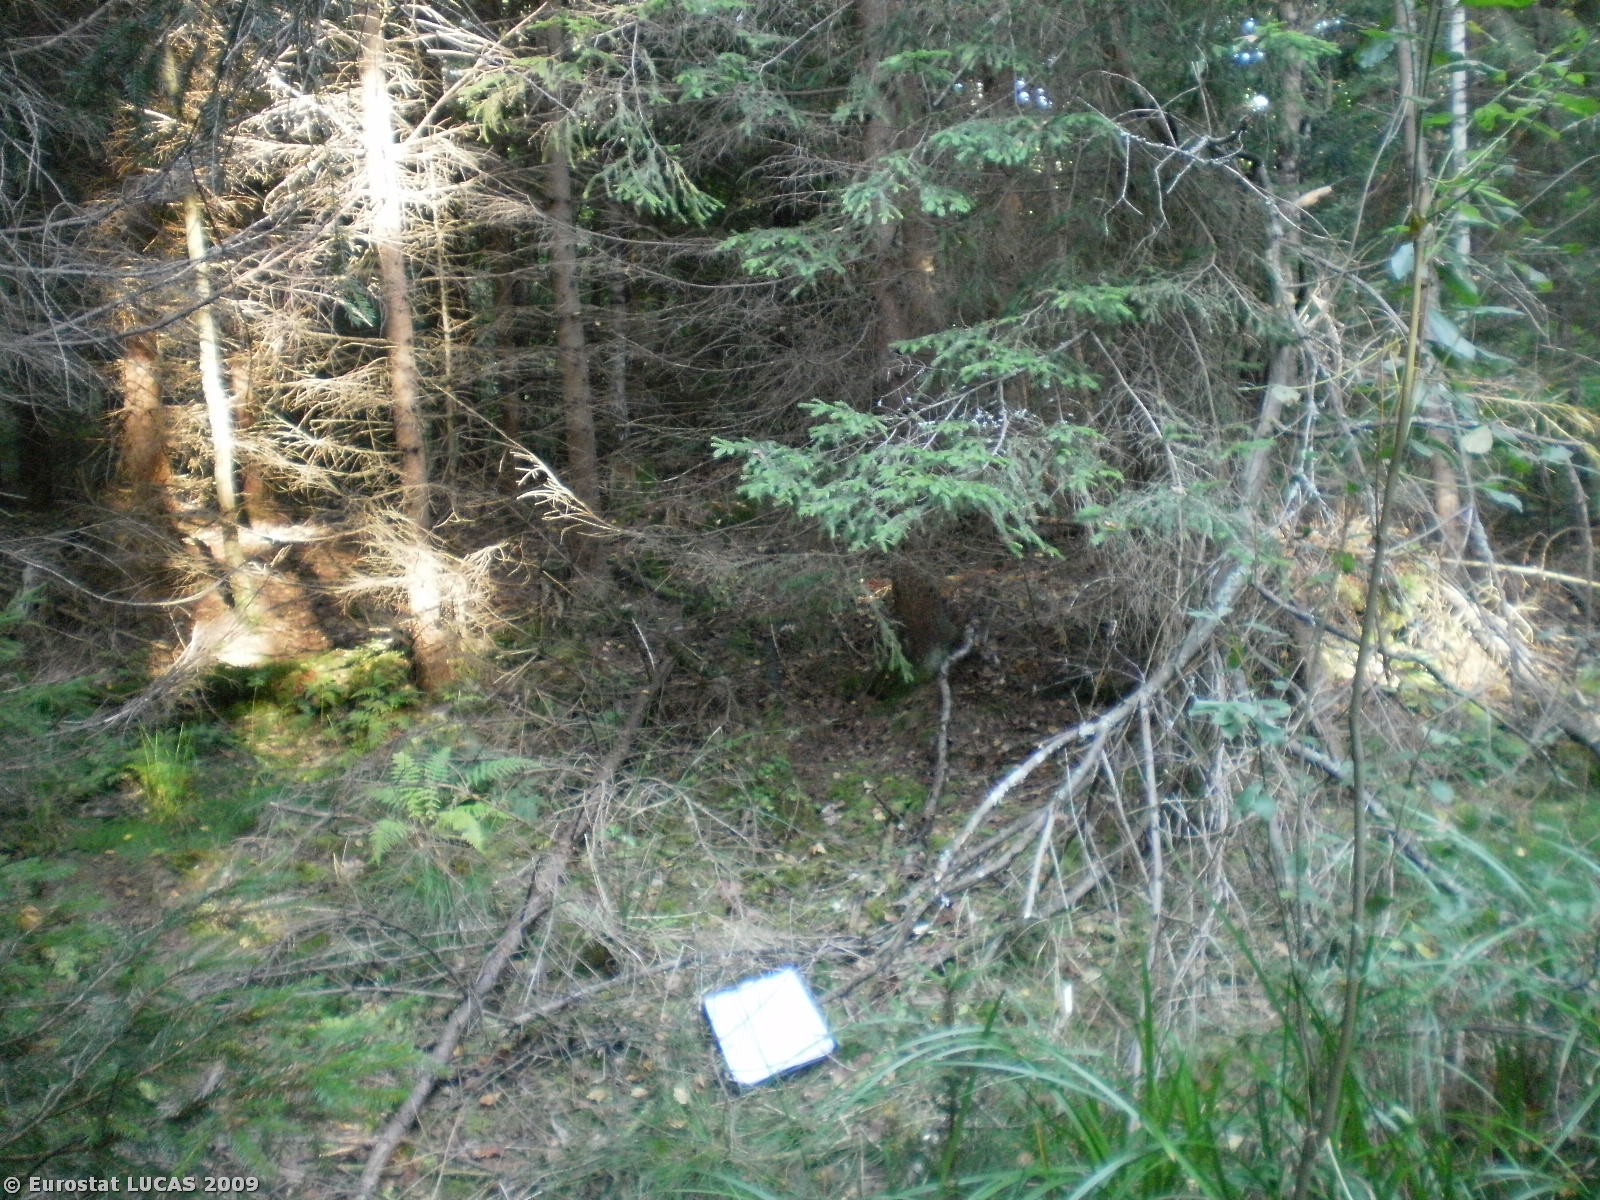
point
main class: Woodland
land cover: Mixed woodland
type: hemiboreal forest and nemoral coniferous forest and mixed broadleaved-coniferous forest
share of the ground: 50 - 75 %
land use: Forestry
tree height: > 5 m
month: August
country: PL
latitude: 54.1705
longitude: 22.1449
